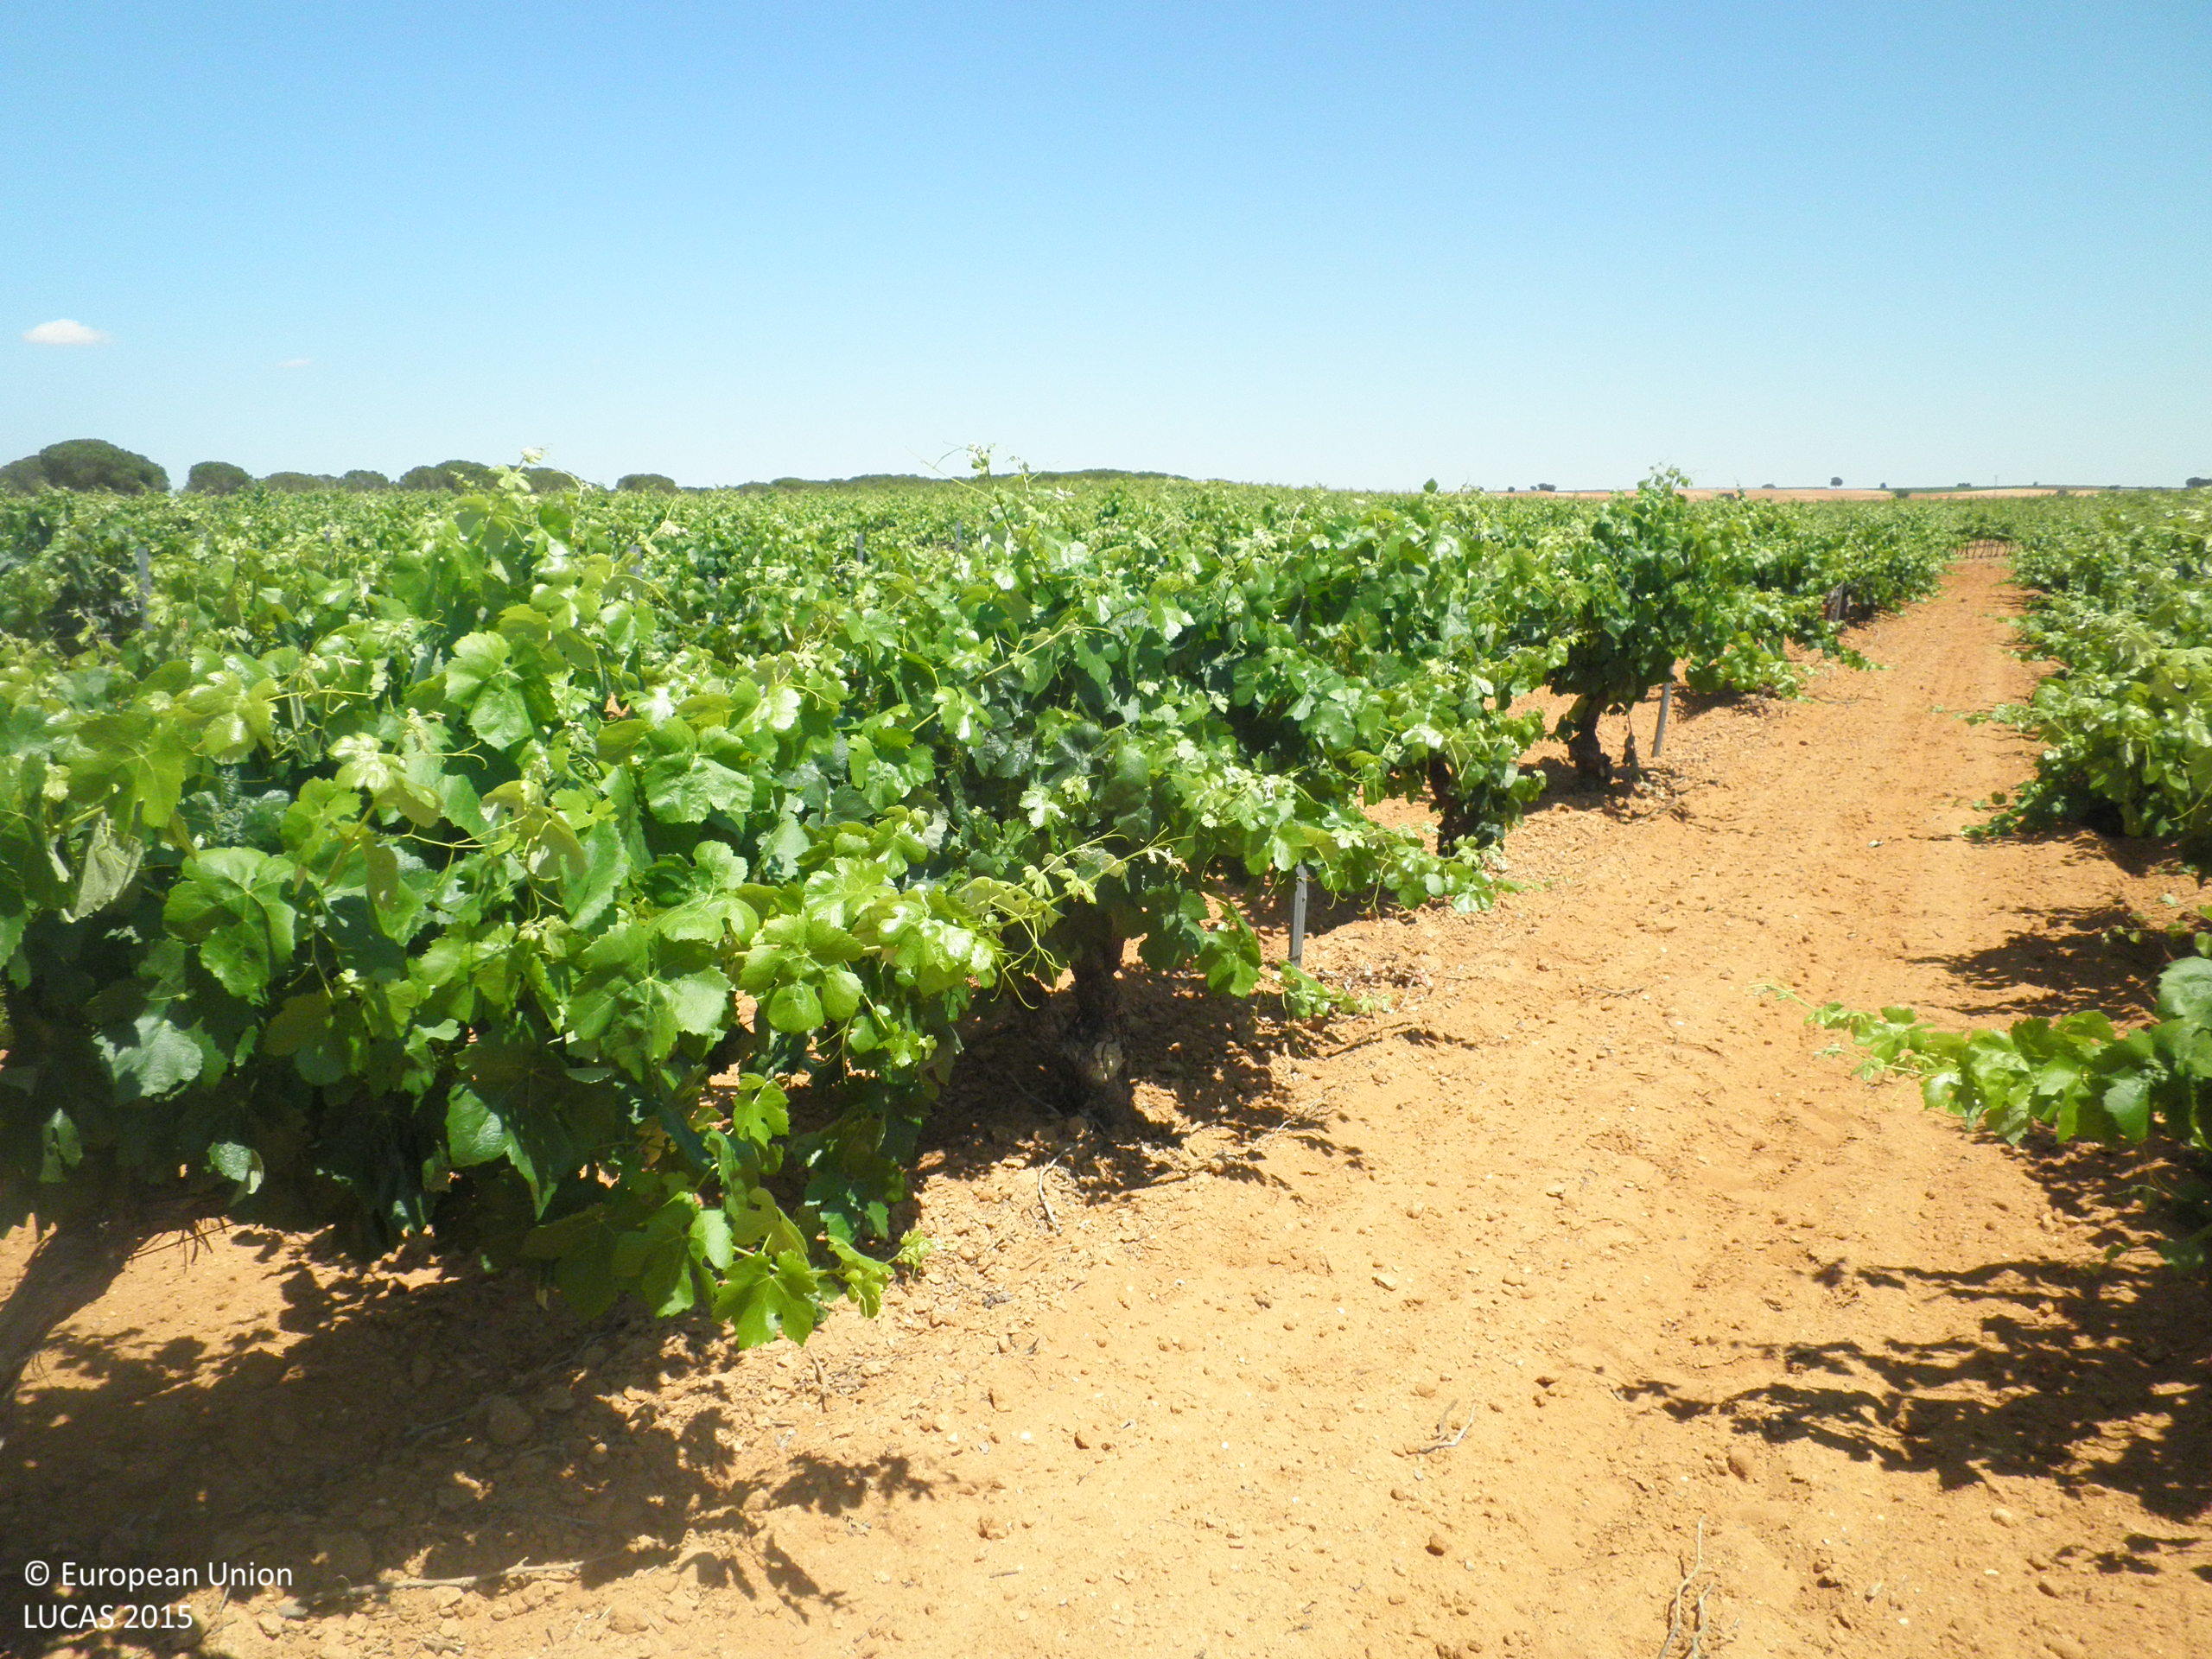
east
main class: Cropland
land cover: Vineyards
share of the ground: 10 - 25 %
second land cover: Other bare soil
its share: > 75 %
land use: Agriculture (excluding fallow land and kitchen gardens)
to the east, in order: Vineyards; Other bare soil
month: June
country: ES
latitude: 39.3659
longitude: -1.8320
